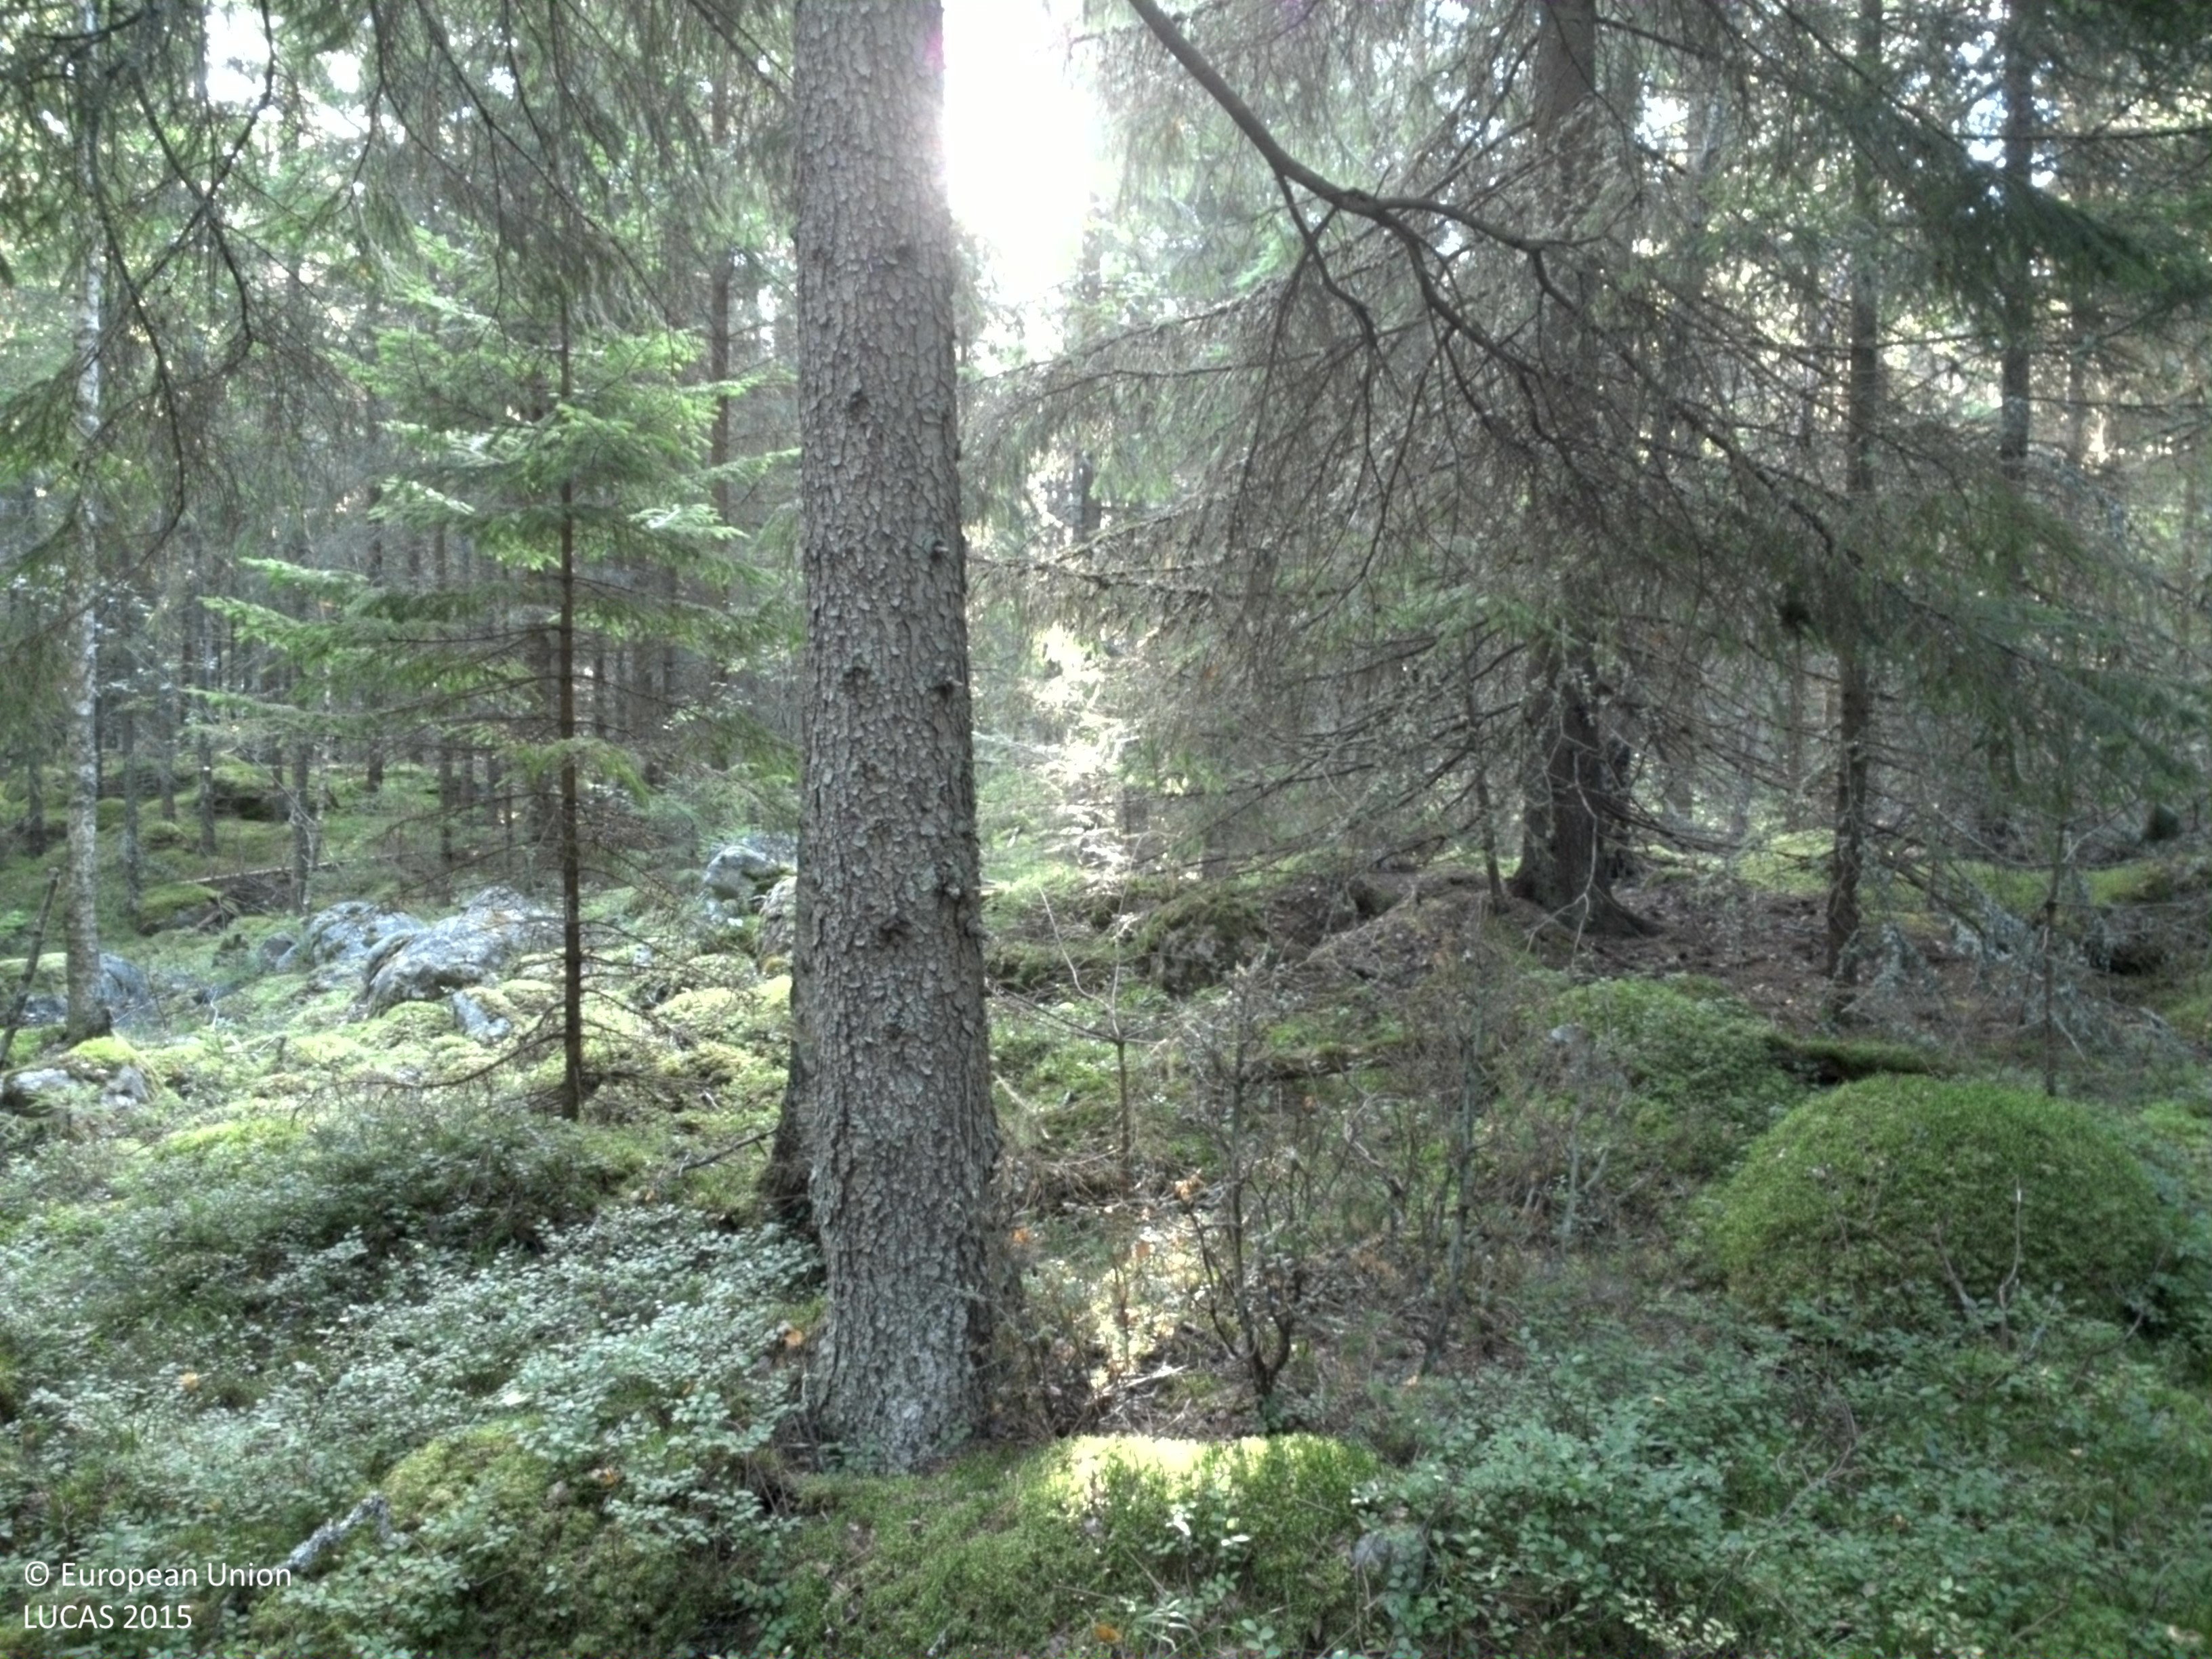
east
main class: Woodland
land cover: Spruce dominated coniferous woodland
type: boreal forest
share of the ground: > 75 %
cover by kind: coniferous forest trees 70 %, shrubs 15 %, lichens and mosses 10 %, broadleaved forest trees 5 %
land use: Forestry
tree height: > 5 m
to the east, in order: Spruce dominated coniferous woodland; Pine dominated coniferous woodland; Other coniferous woodland
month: August
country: SE
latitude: 59.8688
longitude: 17.2260
